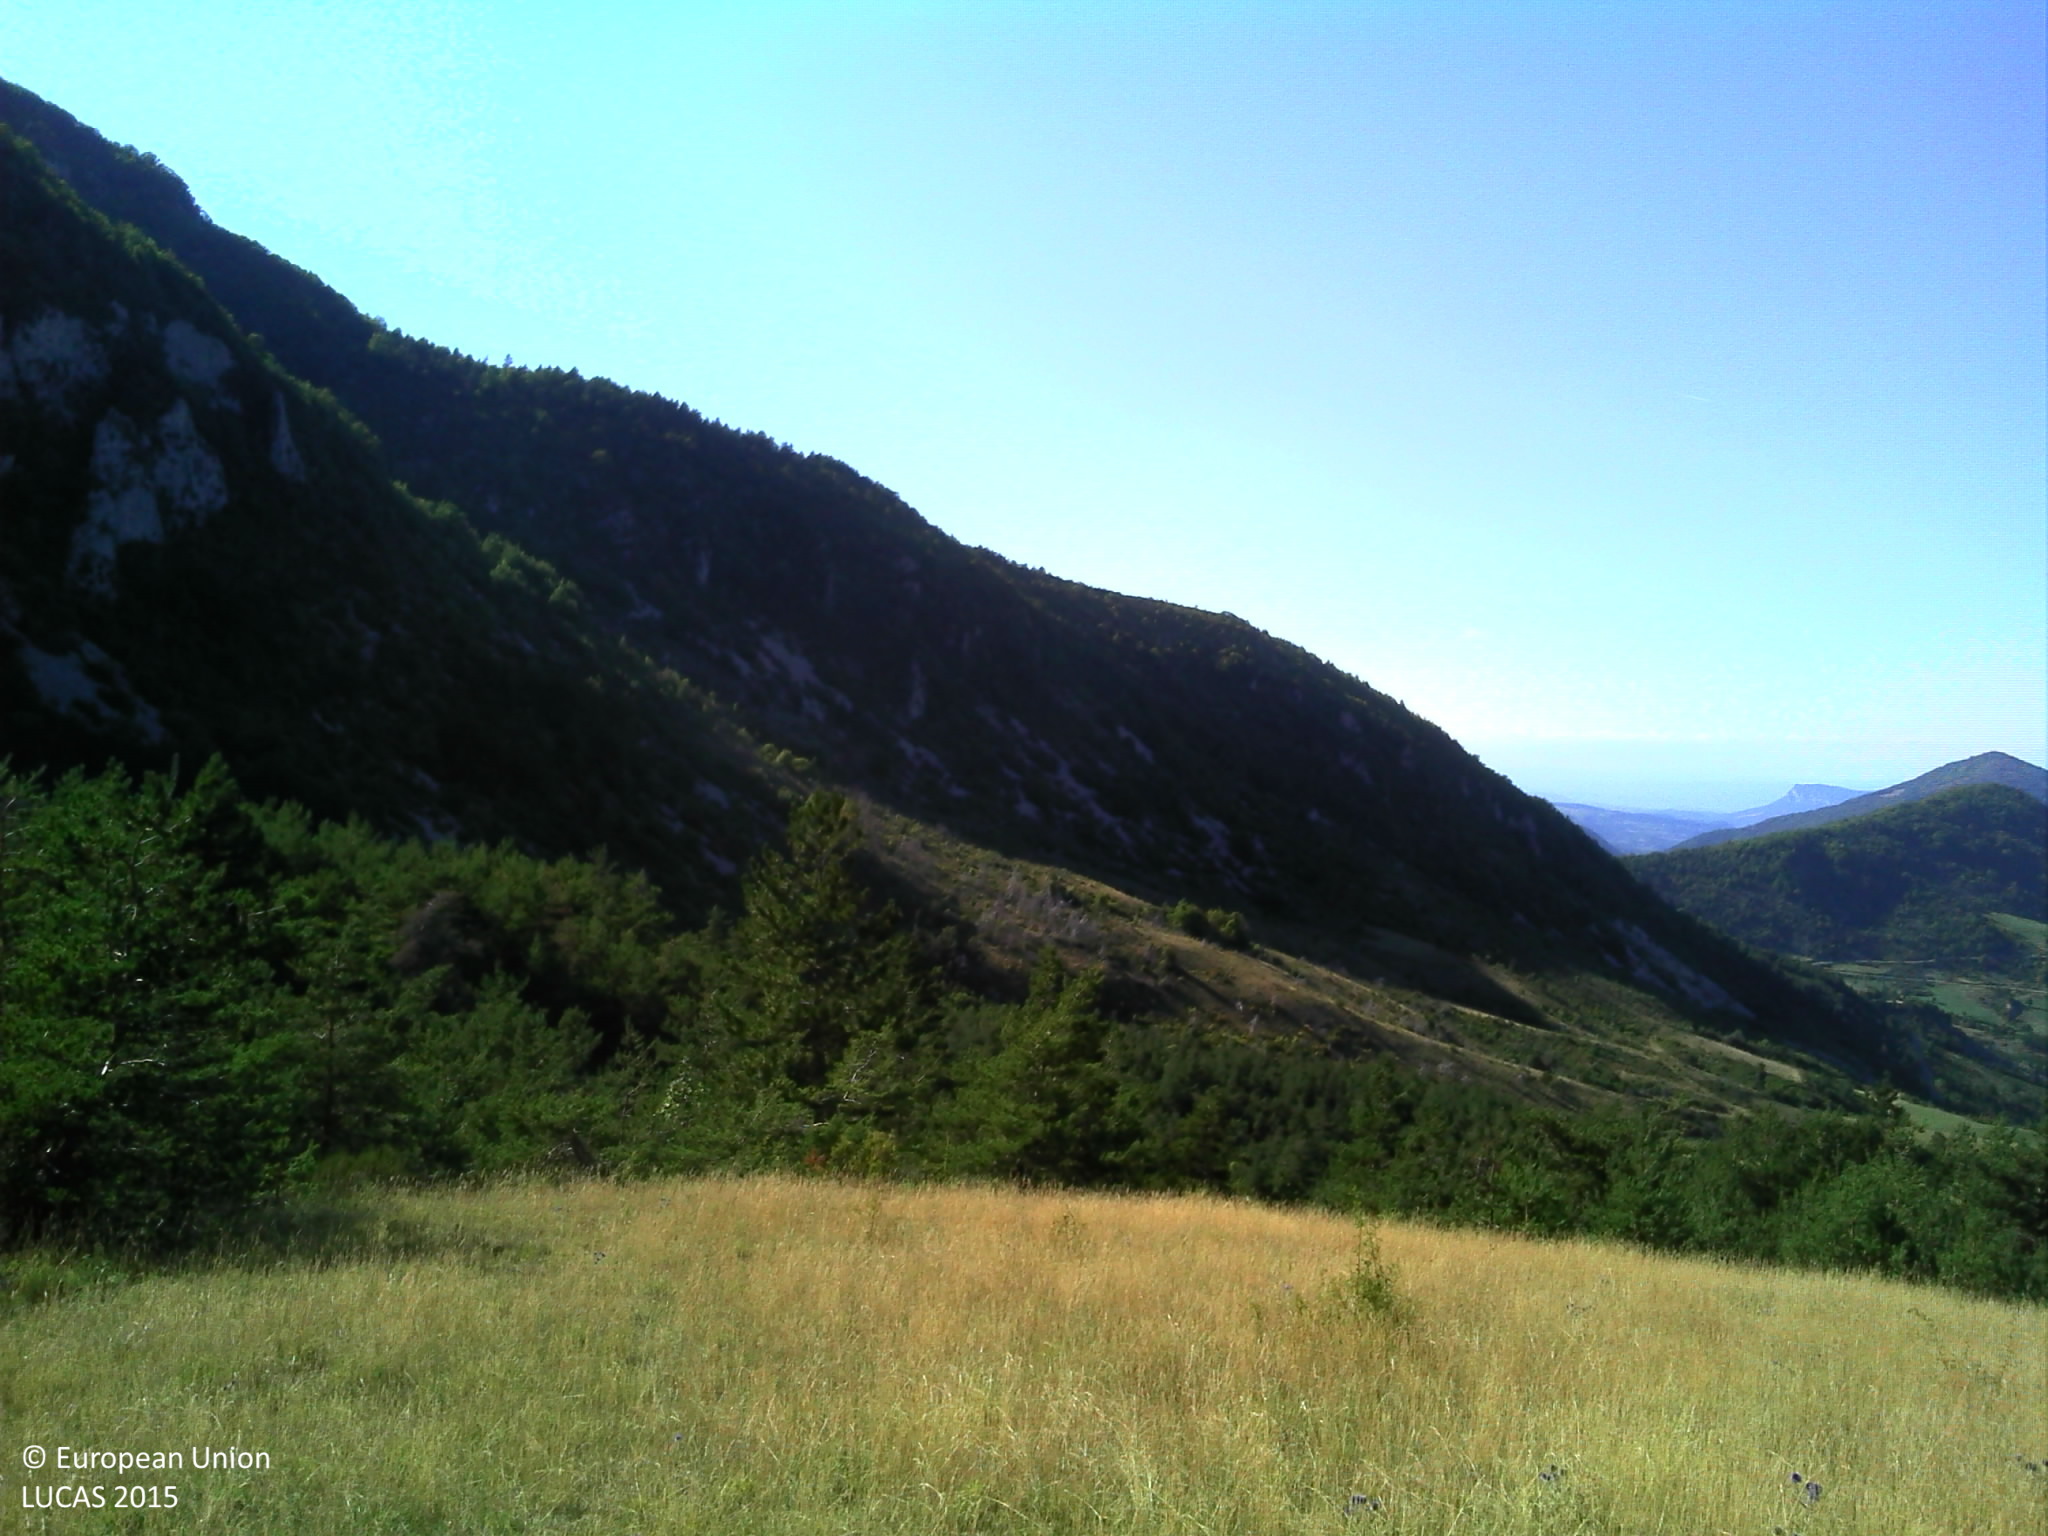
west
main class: Grassland
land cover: Grassland without tree/shrub cover
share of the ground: > 75 %
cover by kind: herbaceous plants 95 %, shrubs 5 %
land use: Agriculture (excluding fallow land and kitchen gardens)
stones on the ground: 25 - 50 %
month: September
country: FR
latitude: 44.4954
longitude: 5.2659
